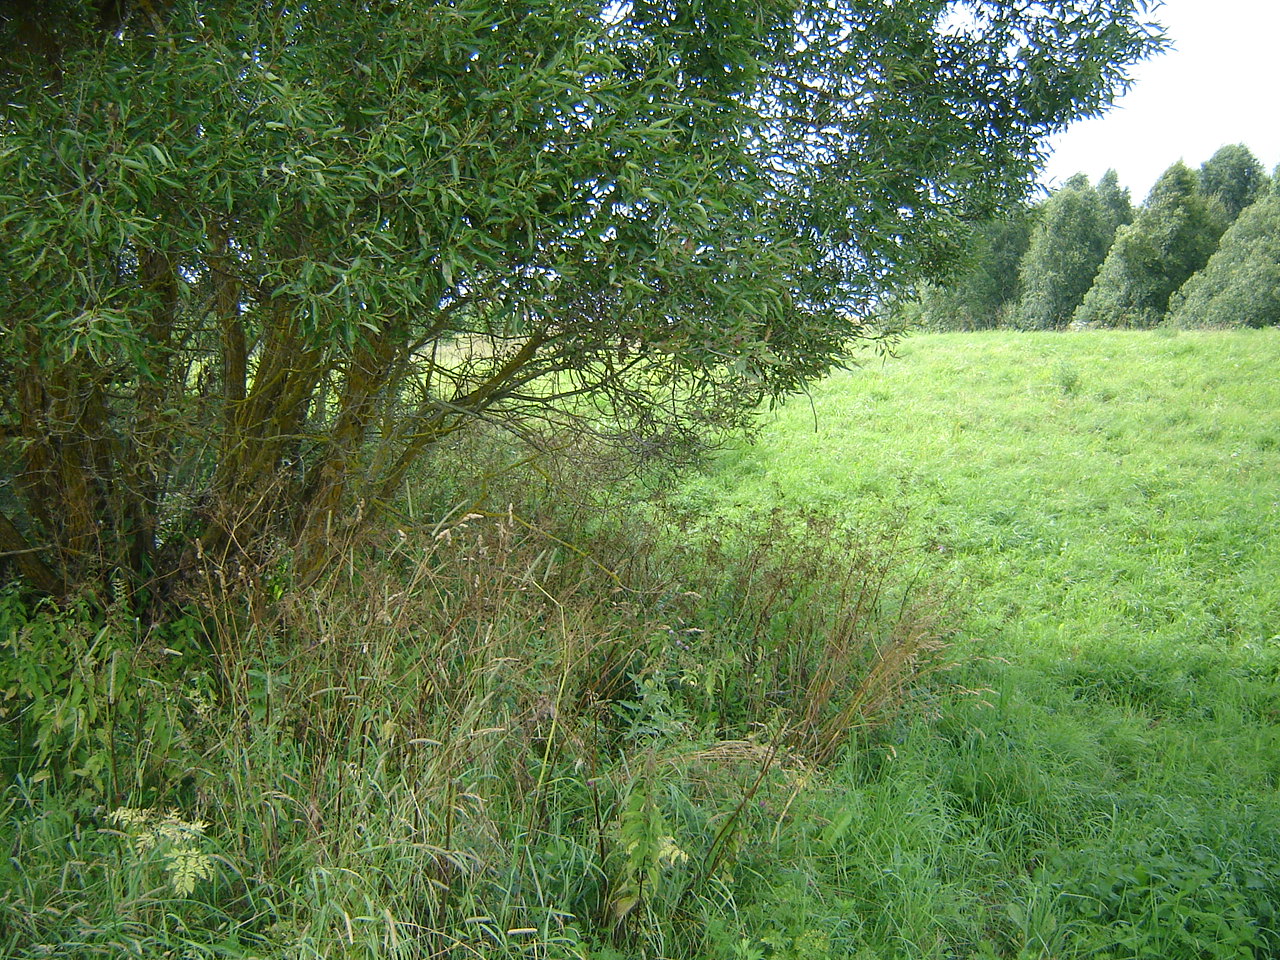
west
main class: Grassland
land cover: Grassland without tree/shrub cover
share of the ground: > 75 %
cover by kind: herbaceous plants 100 %
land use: Agriculture (excluding fallow land and kitchen gardens)
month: July
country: LT
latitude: 55.2667
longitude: 25.1134
